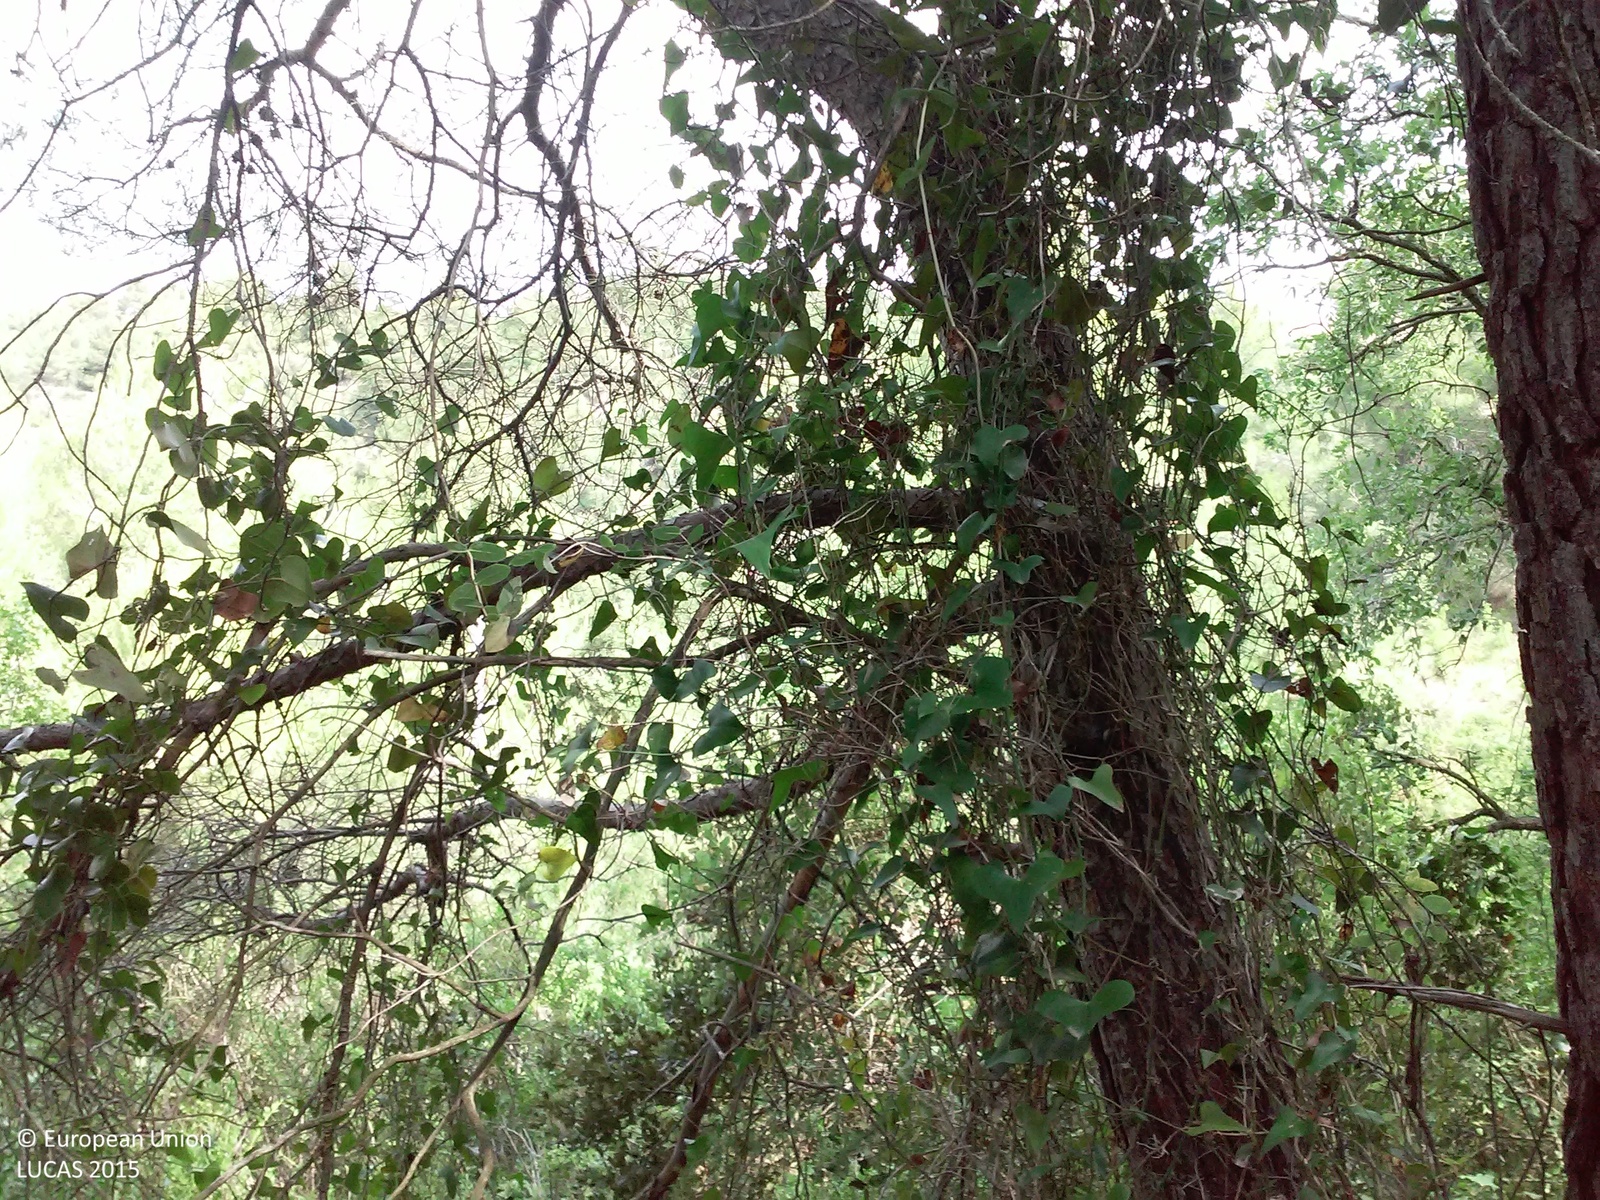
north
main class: Woodland
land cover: Pine dominated coniferous woodland
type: coniferous forest of the mediterranean region
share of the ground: > 75 %
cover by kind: coniferous forest trees 70 %, broadleaved forest trees 10 %, shrubs 10 %, herbaceous plants 10 %
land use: Semi-natural and natural areas not in use
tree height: > 5 m
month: June
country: ES
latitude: 41.3447
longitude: 1.2081
